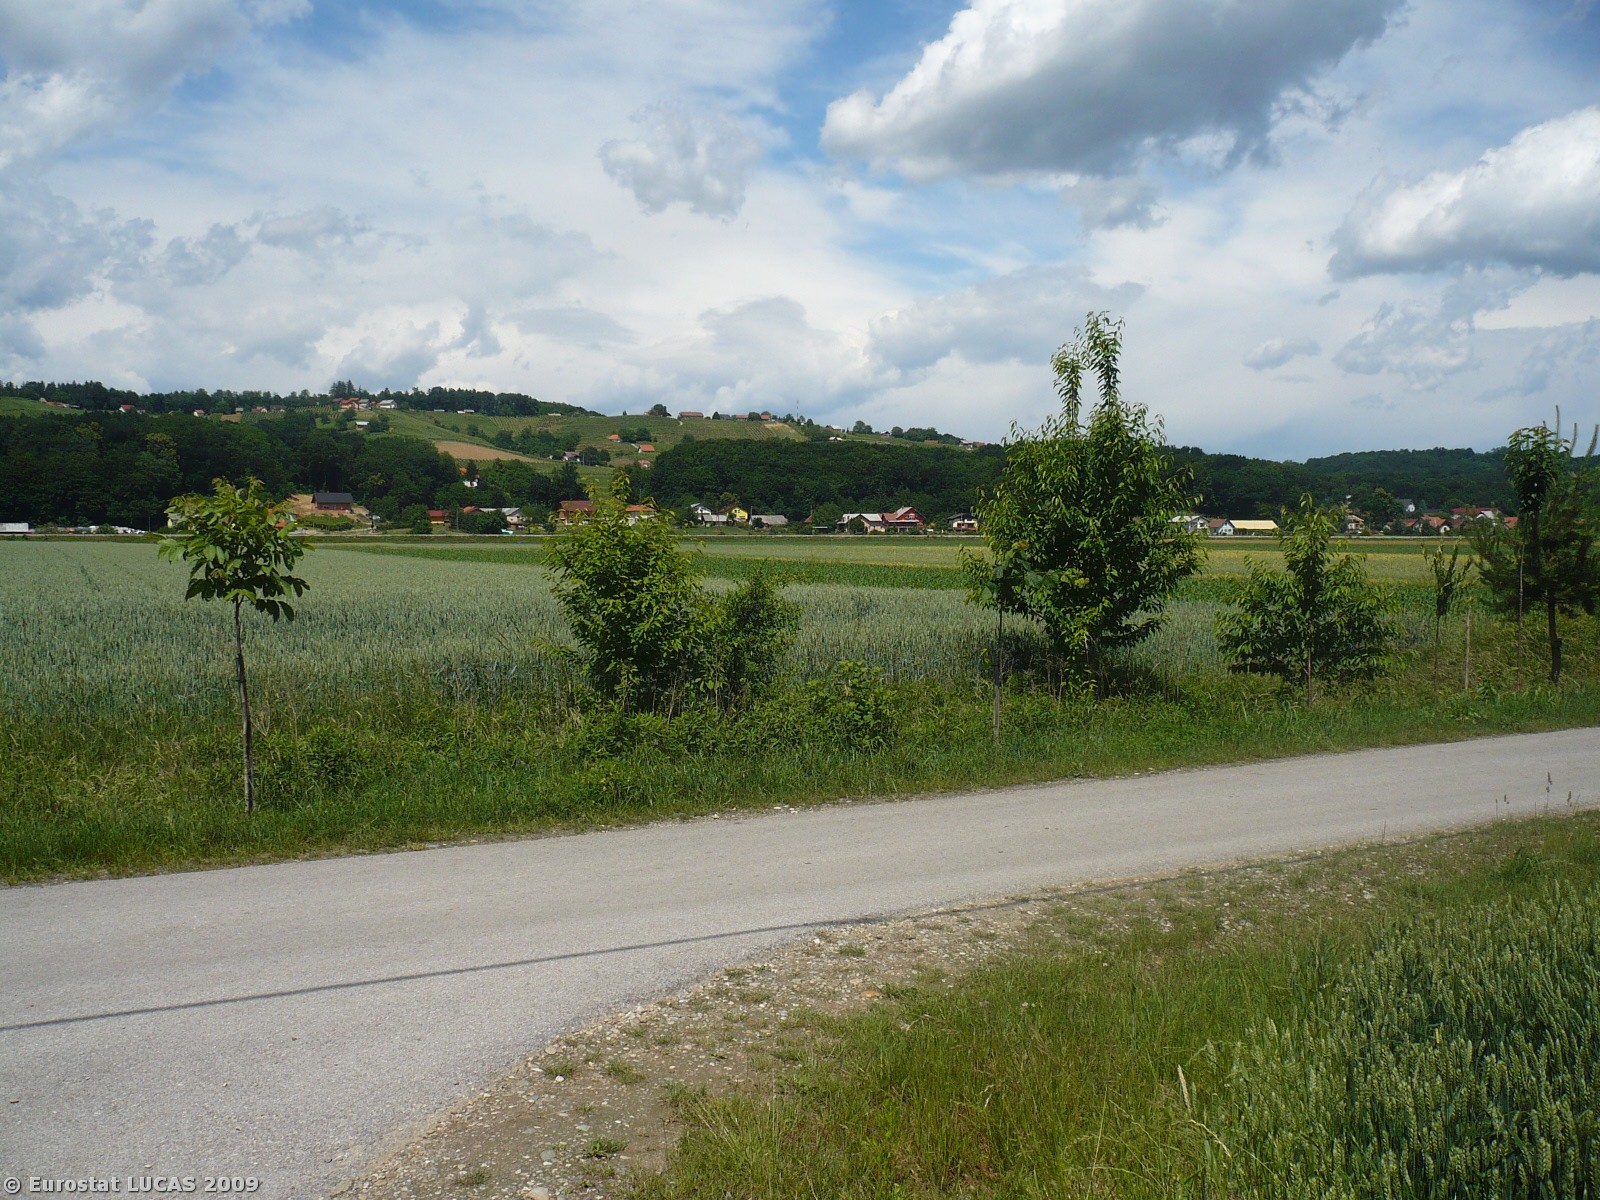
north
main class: Cropland
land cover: Common wheat
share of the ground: > 75 %
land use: Agriculture (excluding fallow land and kitchen gardens)
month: May
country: SI
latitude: 46.4162
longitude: 16.0234
